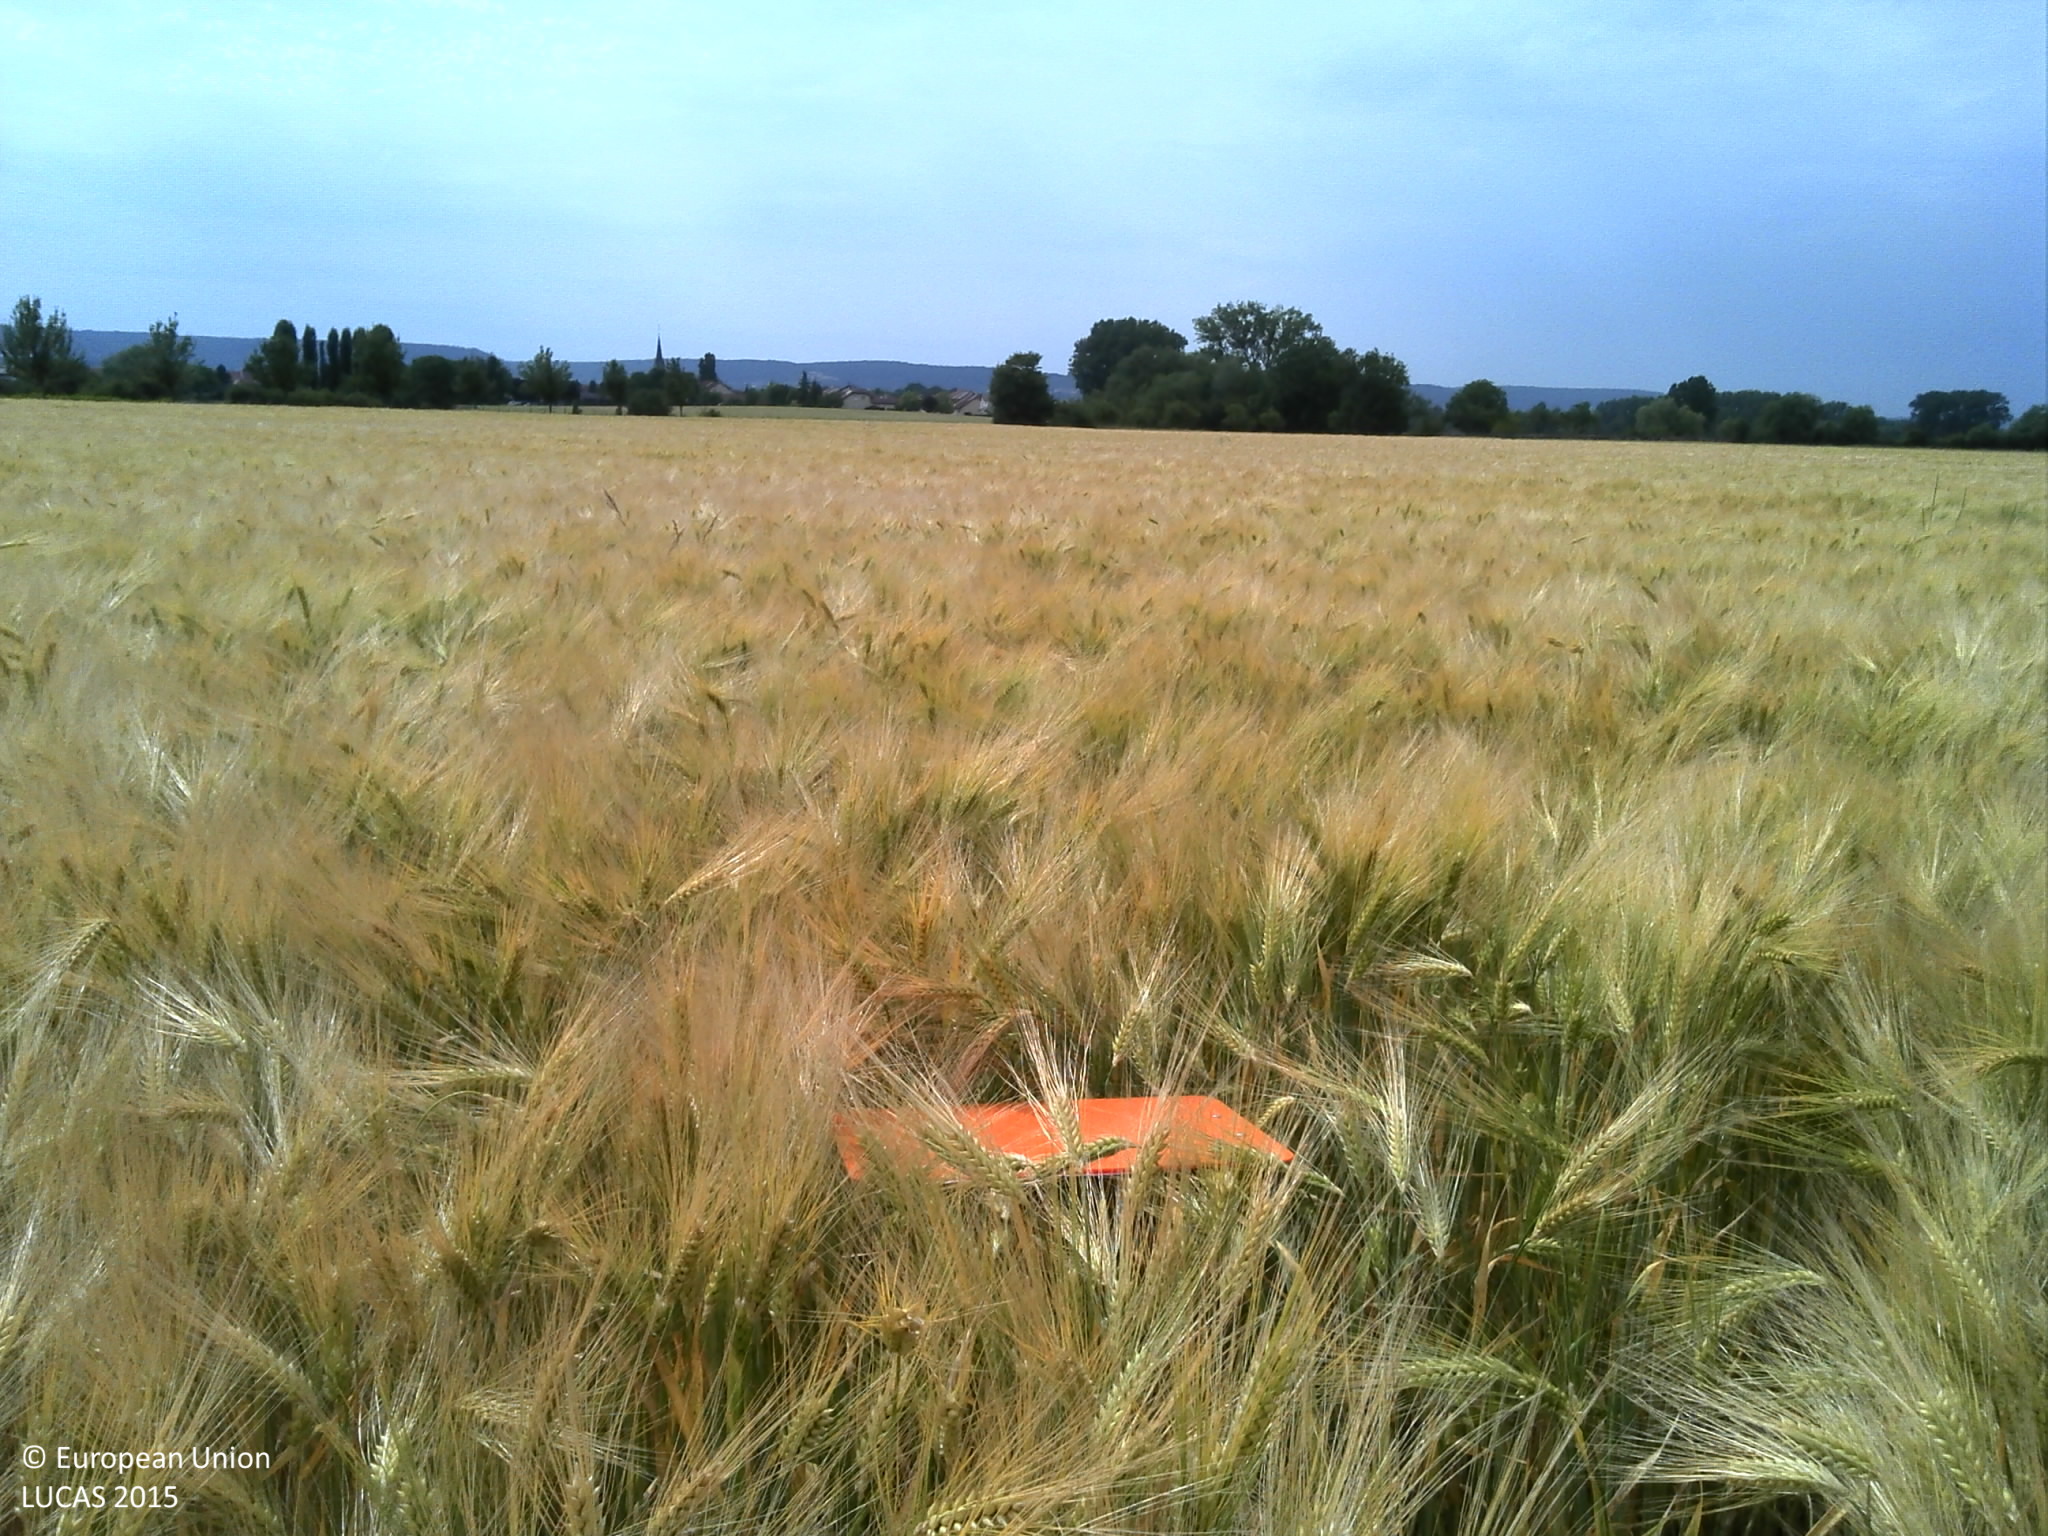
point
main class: Cropland
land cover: Barley
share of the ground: > 75 %
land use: Agriculture (excluding fallow land and kitchen gardens)
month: June
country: FR
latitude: 49.1667
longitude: 6.2007
